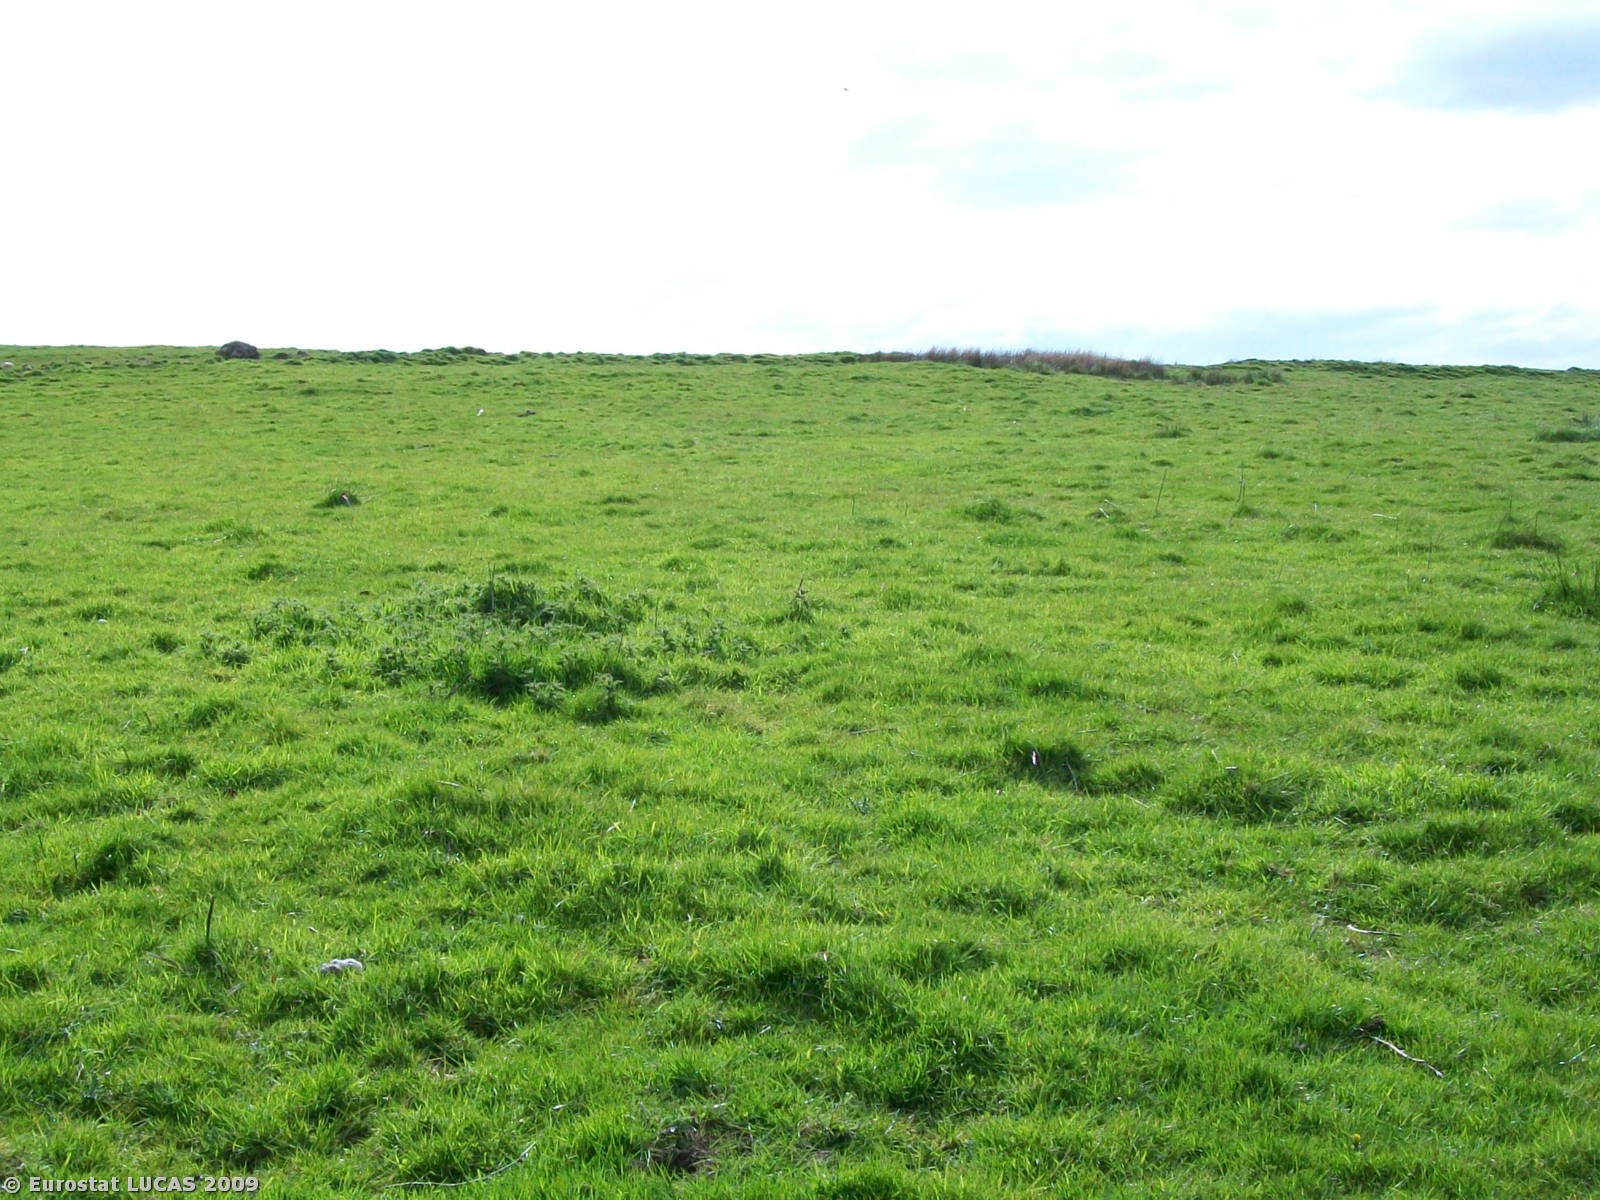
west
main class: Grassland
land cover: Grassland with sparse tree/shrub cover
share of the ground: > 75 %
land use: Agriculture (excluding fallow land and kitchen gardens)
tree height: > 5 m
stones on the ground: < 10 %
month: May
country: GB
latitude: 54.7181
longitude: -3.1935
